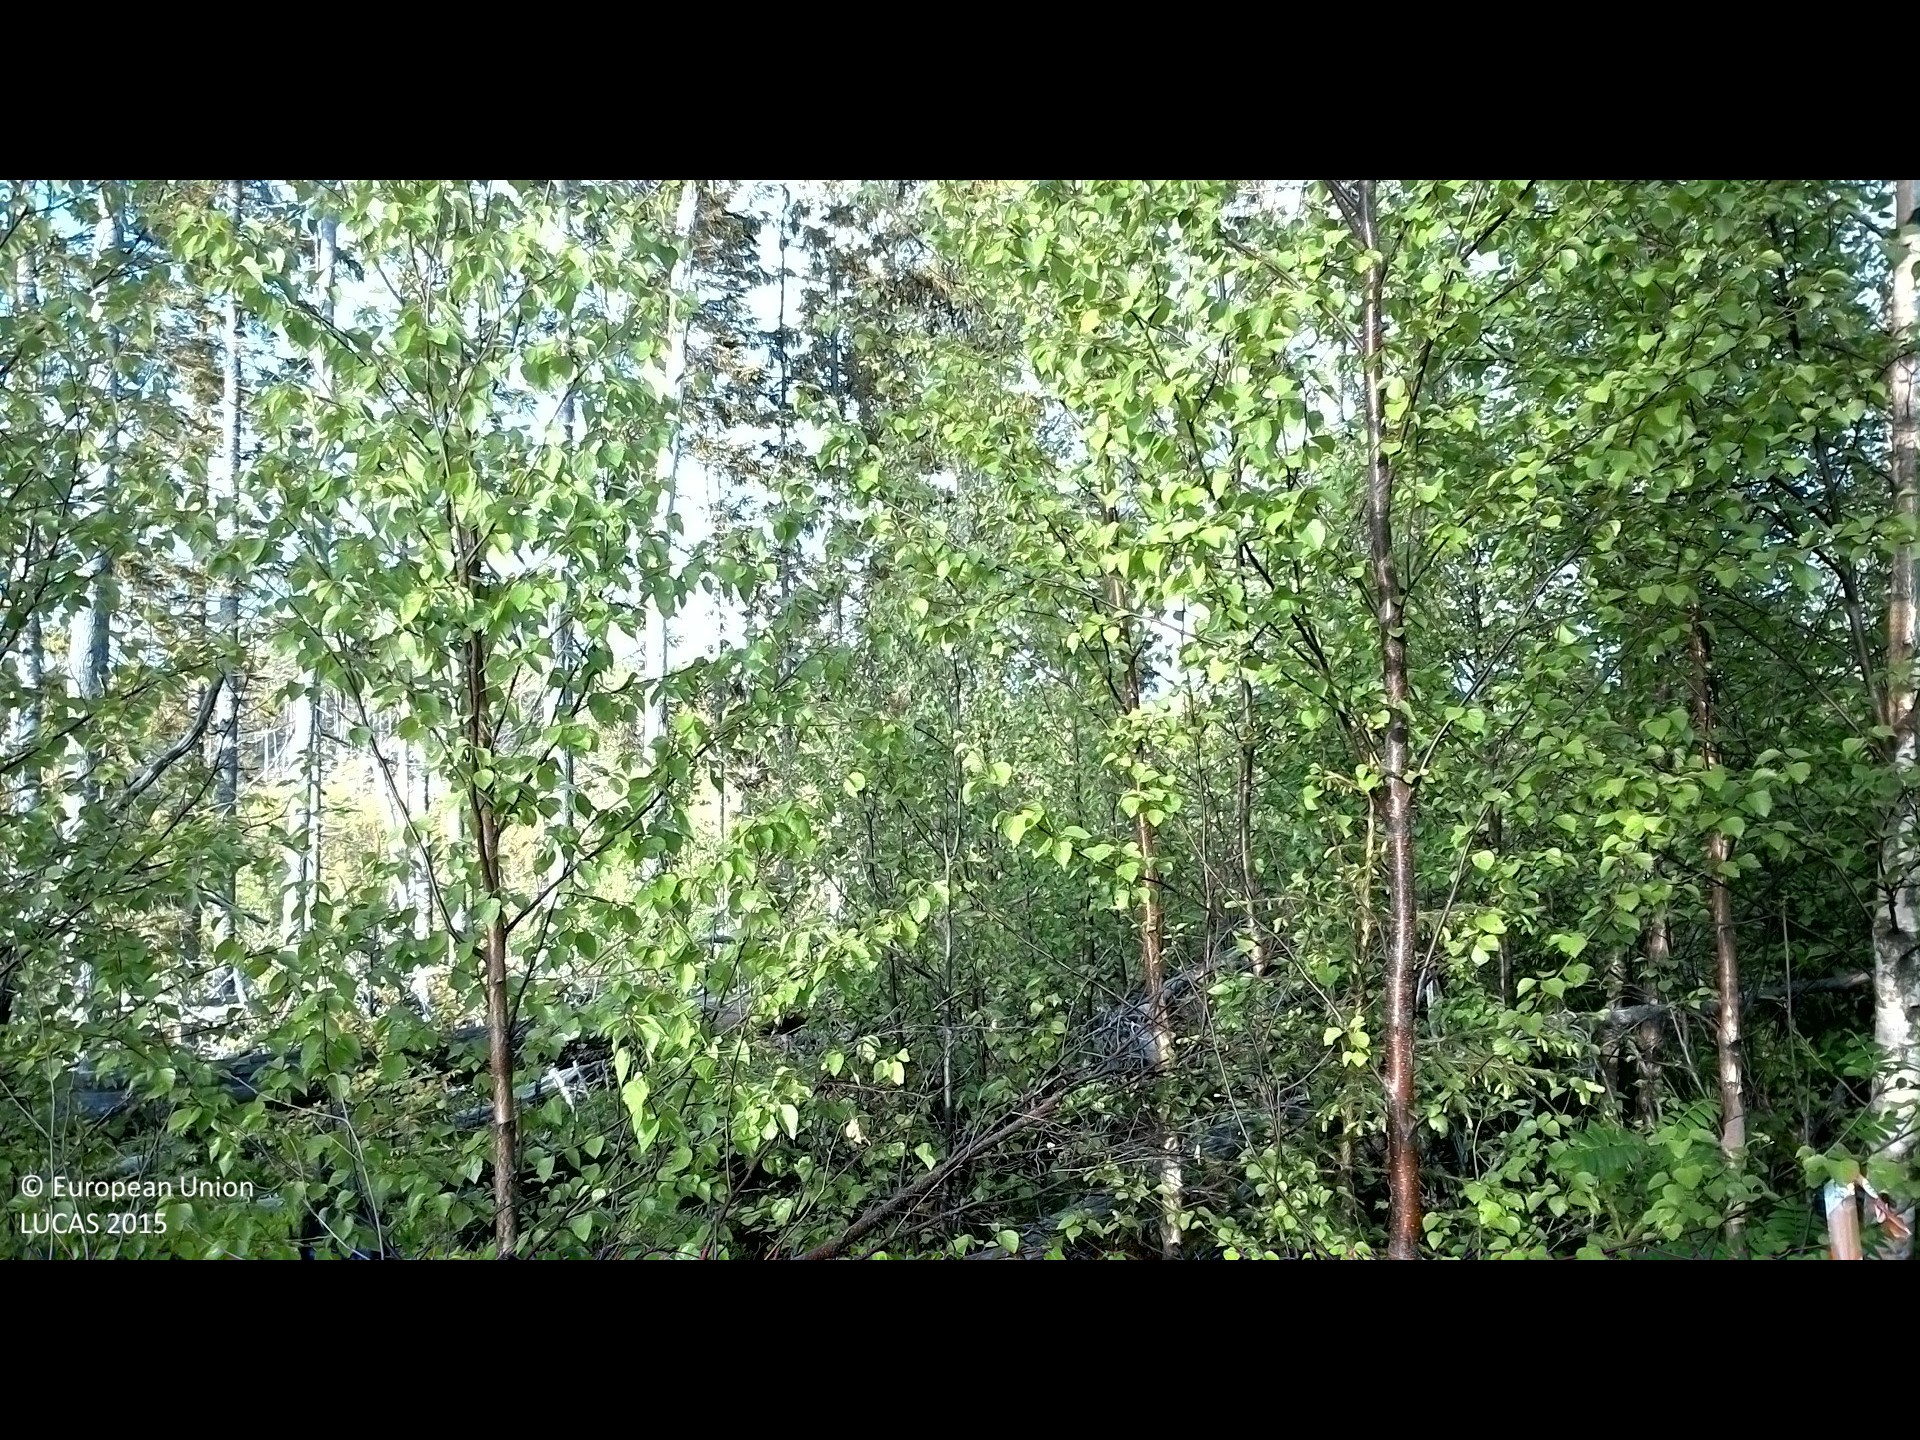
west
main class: Woodland
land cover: Spruce dominated coniferous woodland
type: boreal forest
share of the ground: 25 - 50 %
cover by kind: herbaceous plants 50 %, coniferous forest trees 25 %, lichens and mosses 20 %, broadleaved forest trees 5 %
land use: Forestry
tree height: < 5 m
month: June
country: SE
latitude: 62.0276
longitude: 16.7279
